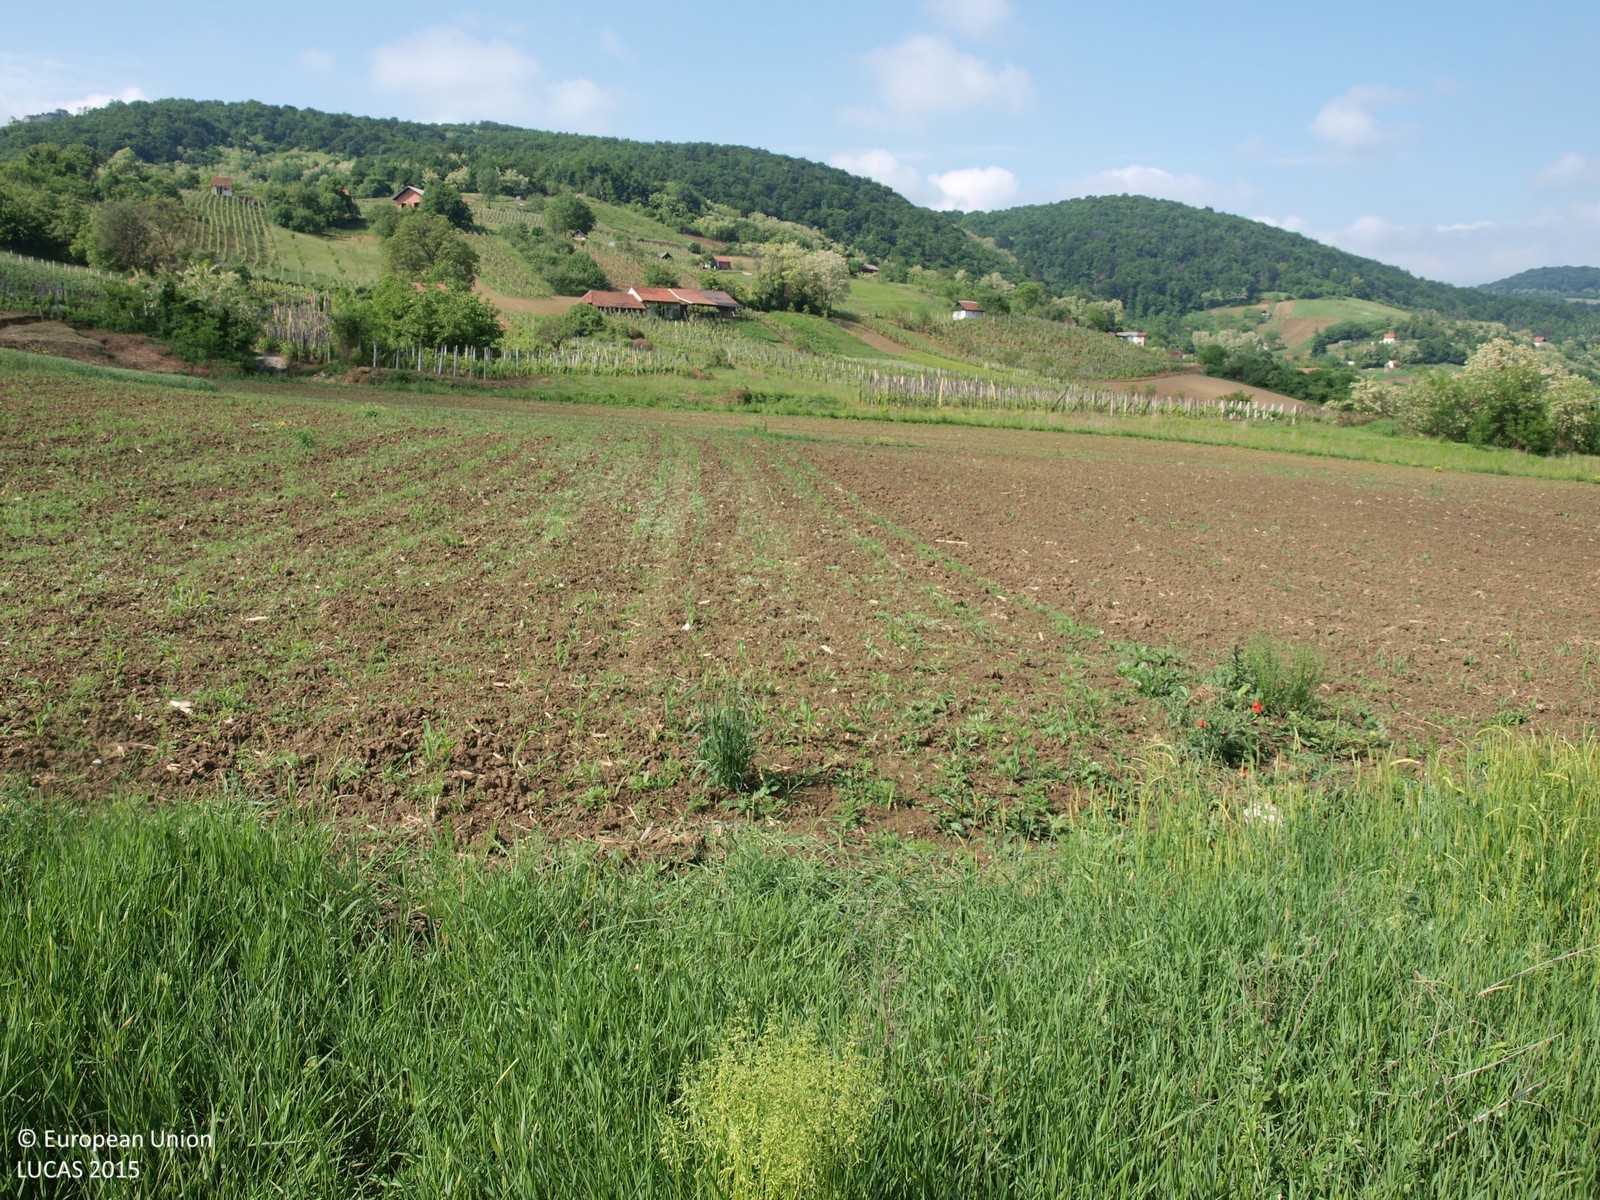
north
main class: Grassland
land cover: Grassland without tree/shrub cover
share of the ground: > 75 %
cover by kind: herbaceous plants 100 %
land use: Agriculture (excluding fallow land and kitchen gardens)
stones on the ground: < 10 %
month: May
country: HR
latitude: 46.1547
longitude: 16.1757
